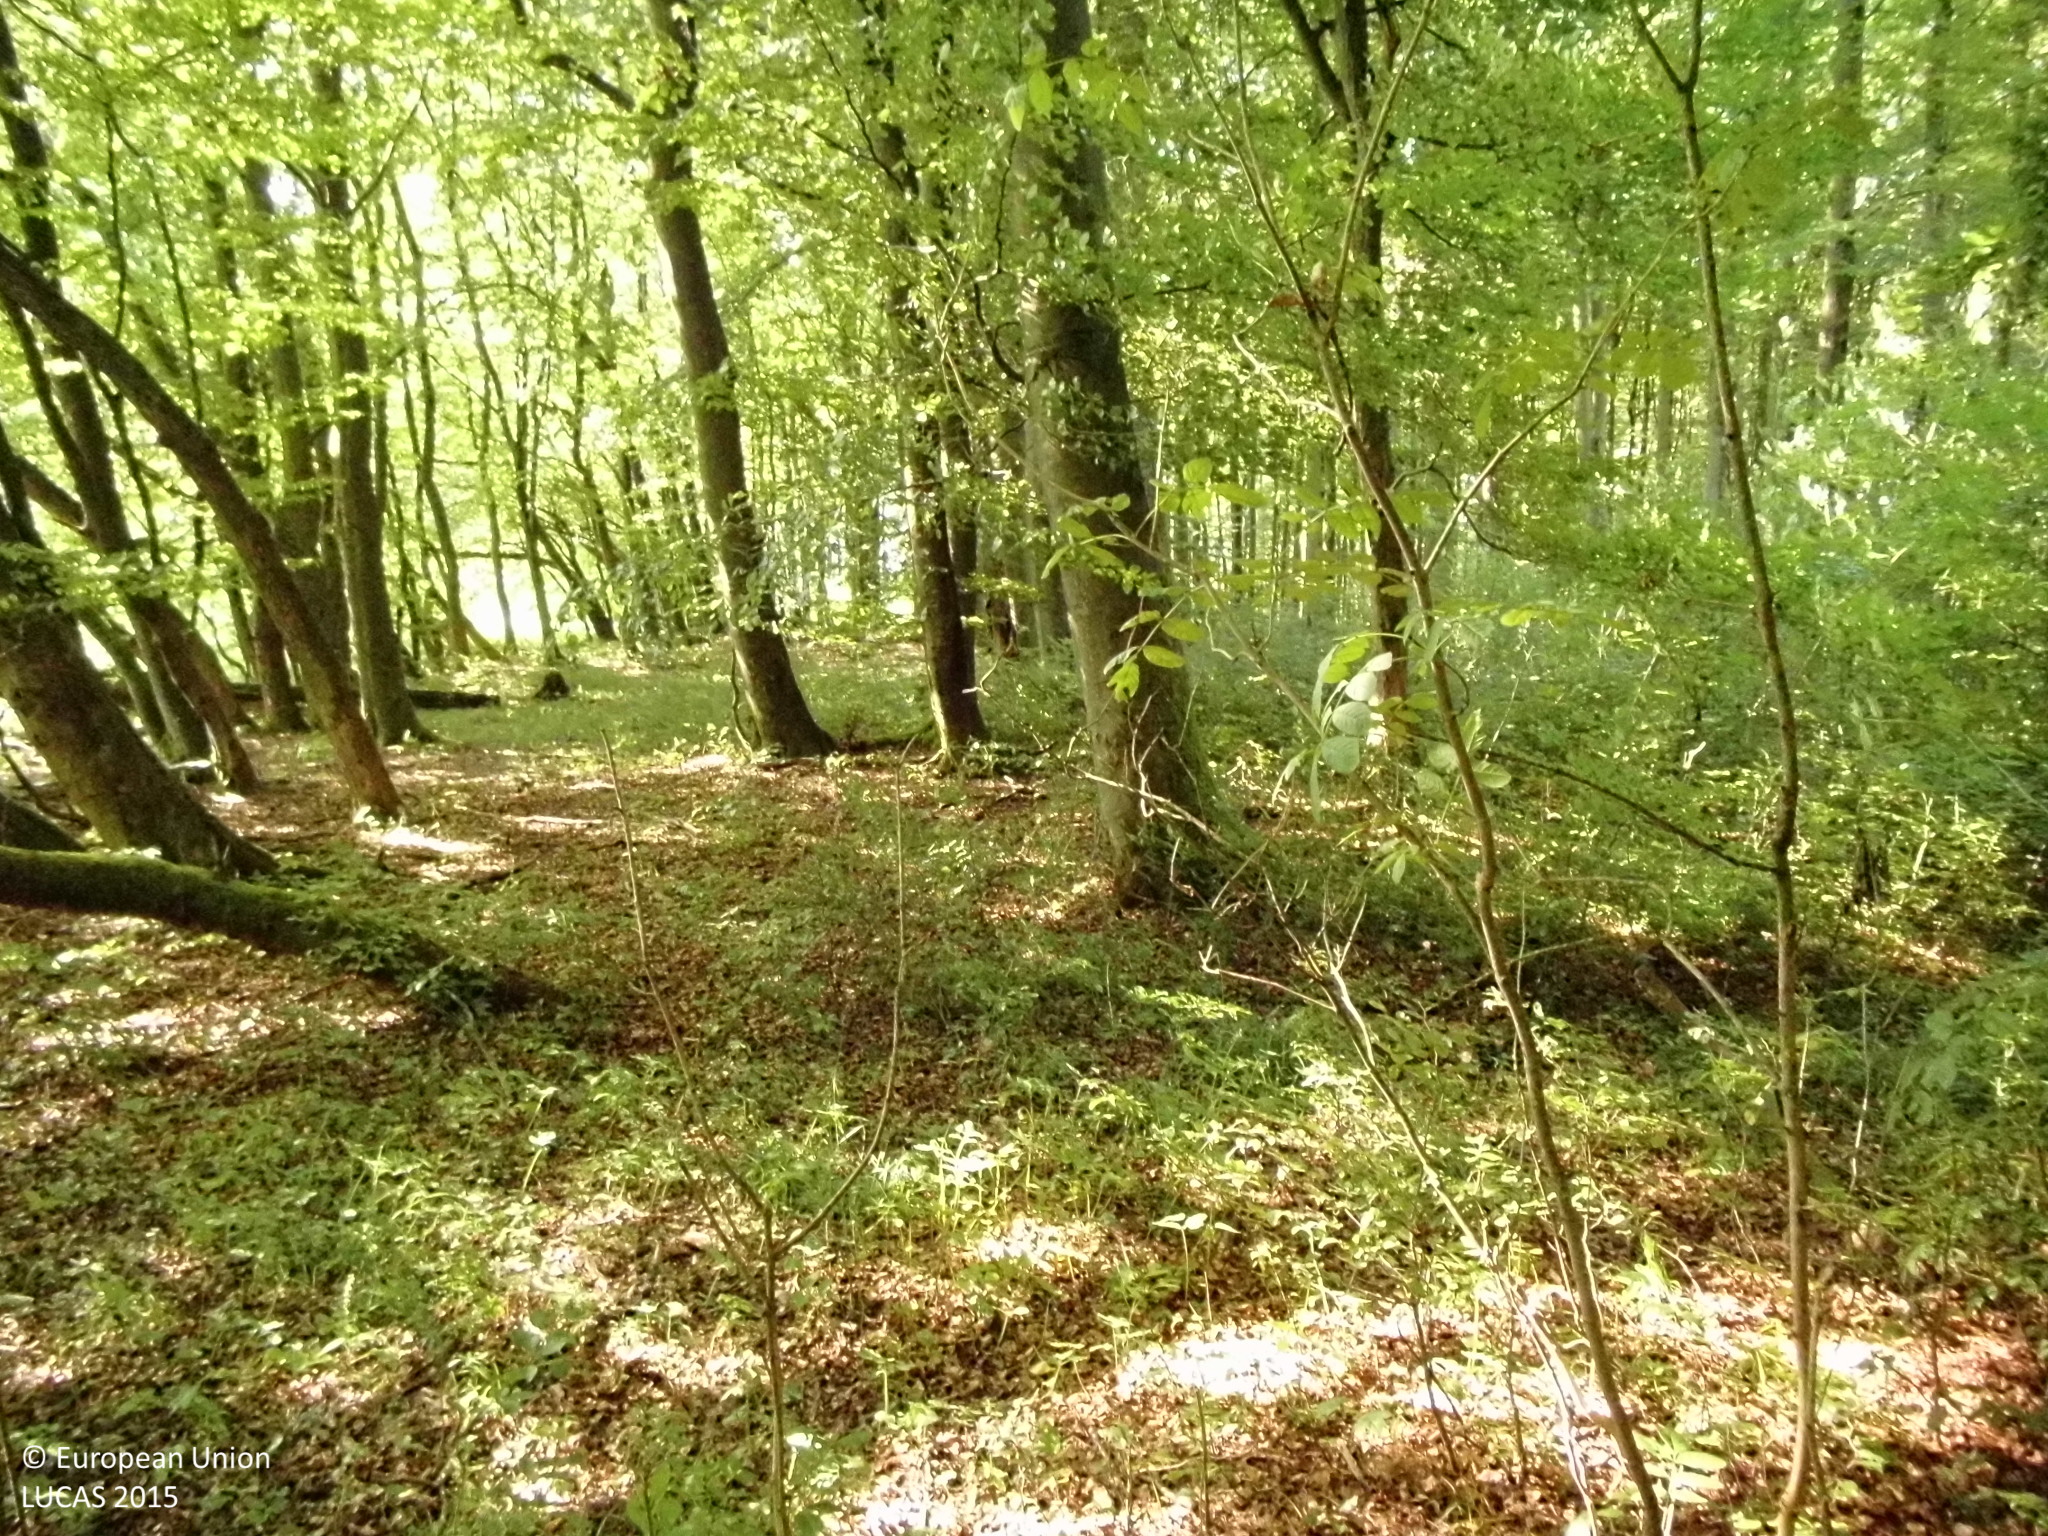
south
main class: Woodland
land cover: Broadleaved woodland
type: mesophytic deciduous forest
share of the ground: > 75 %
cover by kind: broadleaved forest trees 100 %
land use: Forestry
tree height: > 5 m
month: August
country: DE
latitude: 50.5985
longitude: 8.0083
